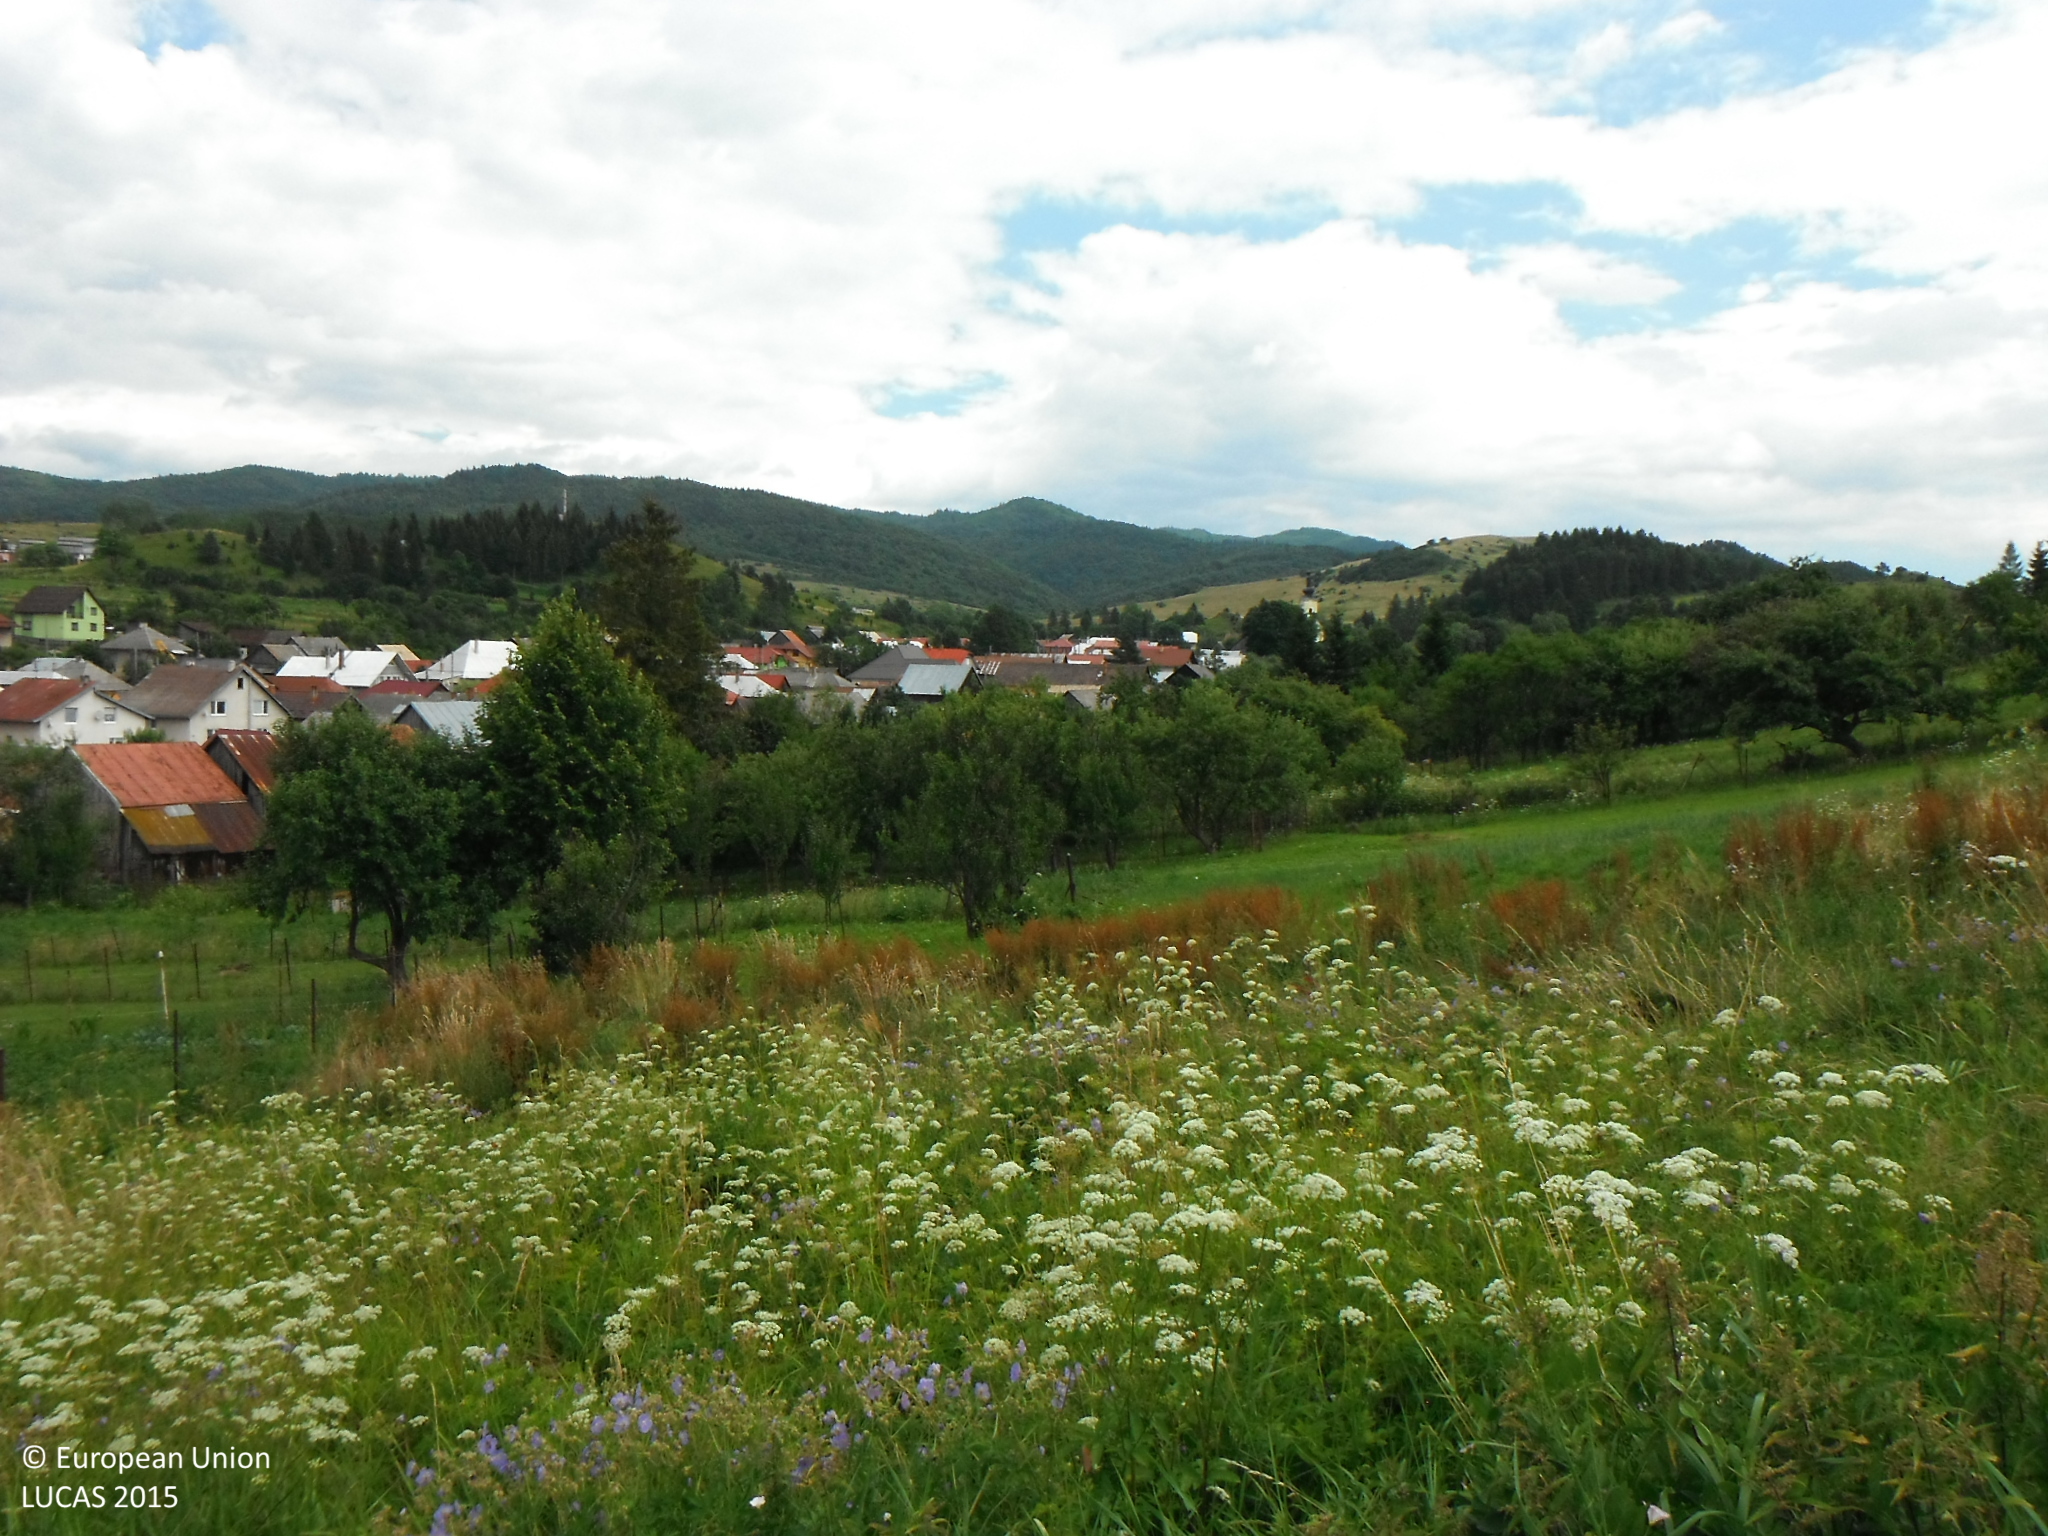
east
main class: Grassland
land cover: Spontaneously vegetated surfaces
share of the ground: > 75 %
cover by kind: herbaceous plants 100 %
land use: Abandoned areas
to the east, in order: Spontaneously vegetated surfaces; Grassland without tree/shrub cover; Fences; Grassland with sparse tree/shrub cover; Fences; Apple fruit; Grassland without tree/shrub cover; Potatoes; Grassland without tree/shrub cover; Artificial constructions in urban areas
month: July
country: SK
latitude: 49.2419
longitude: 20.9062
